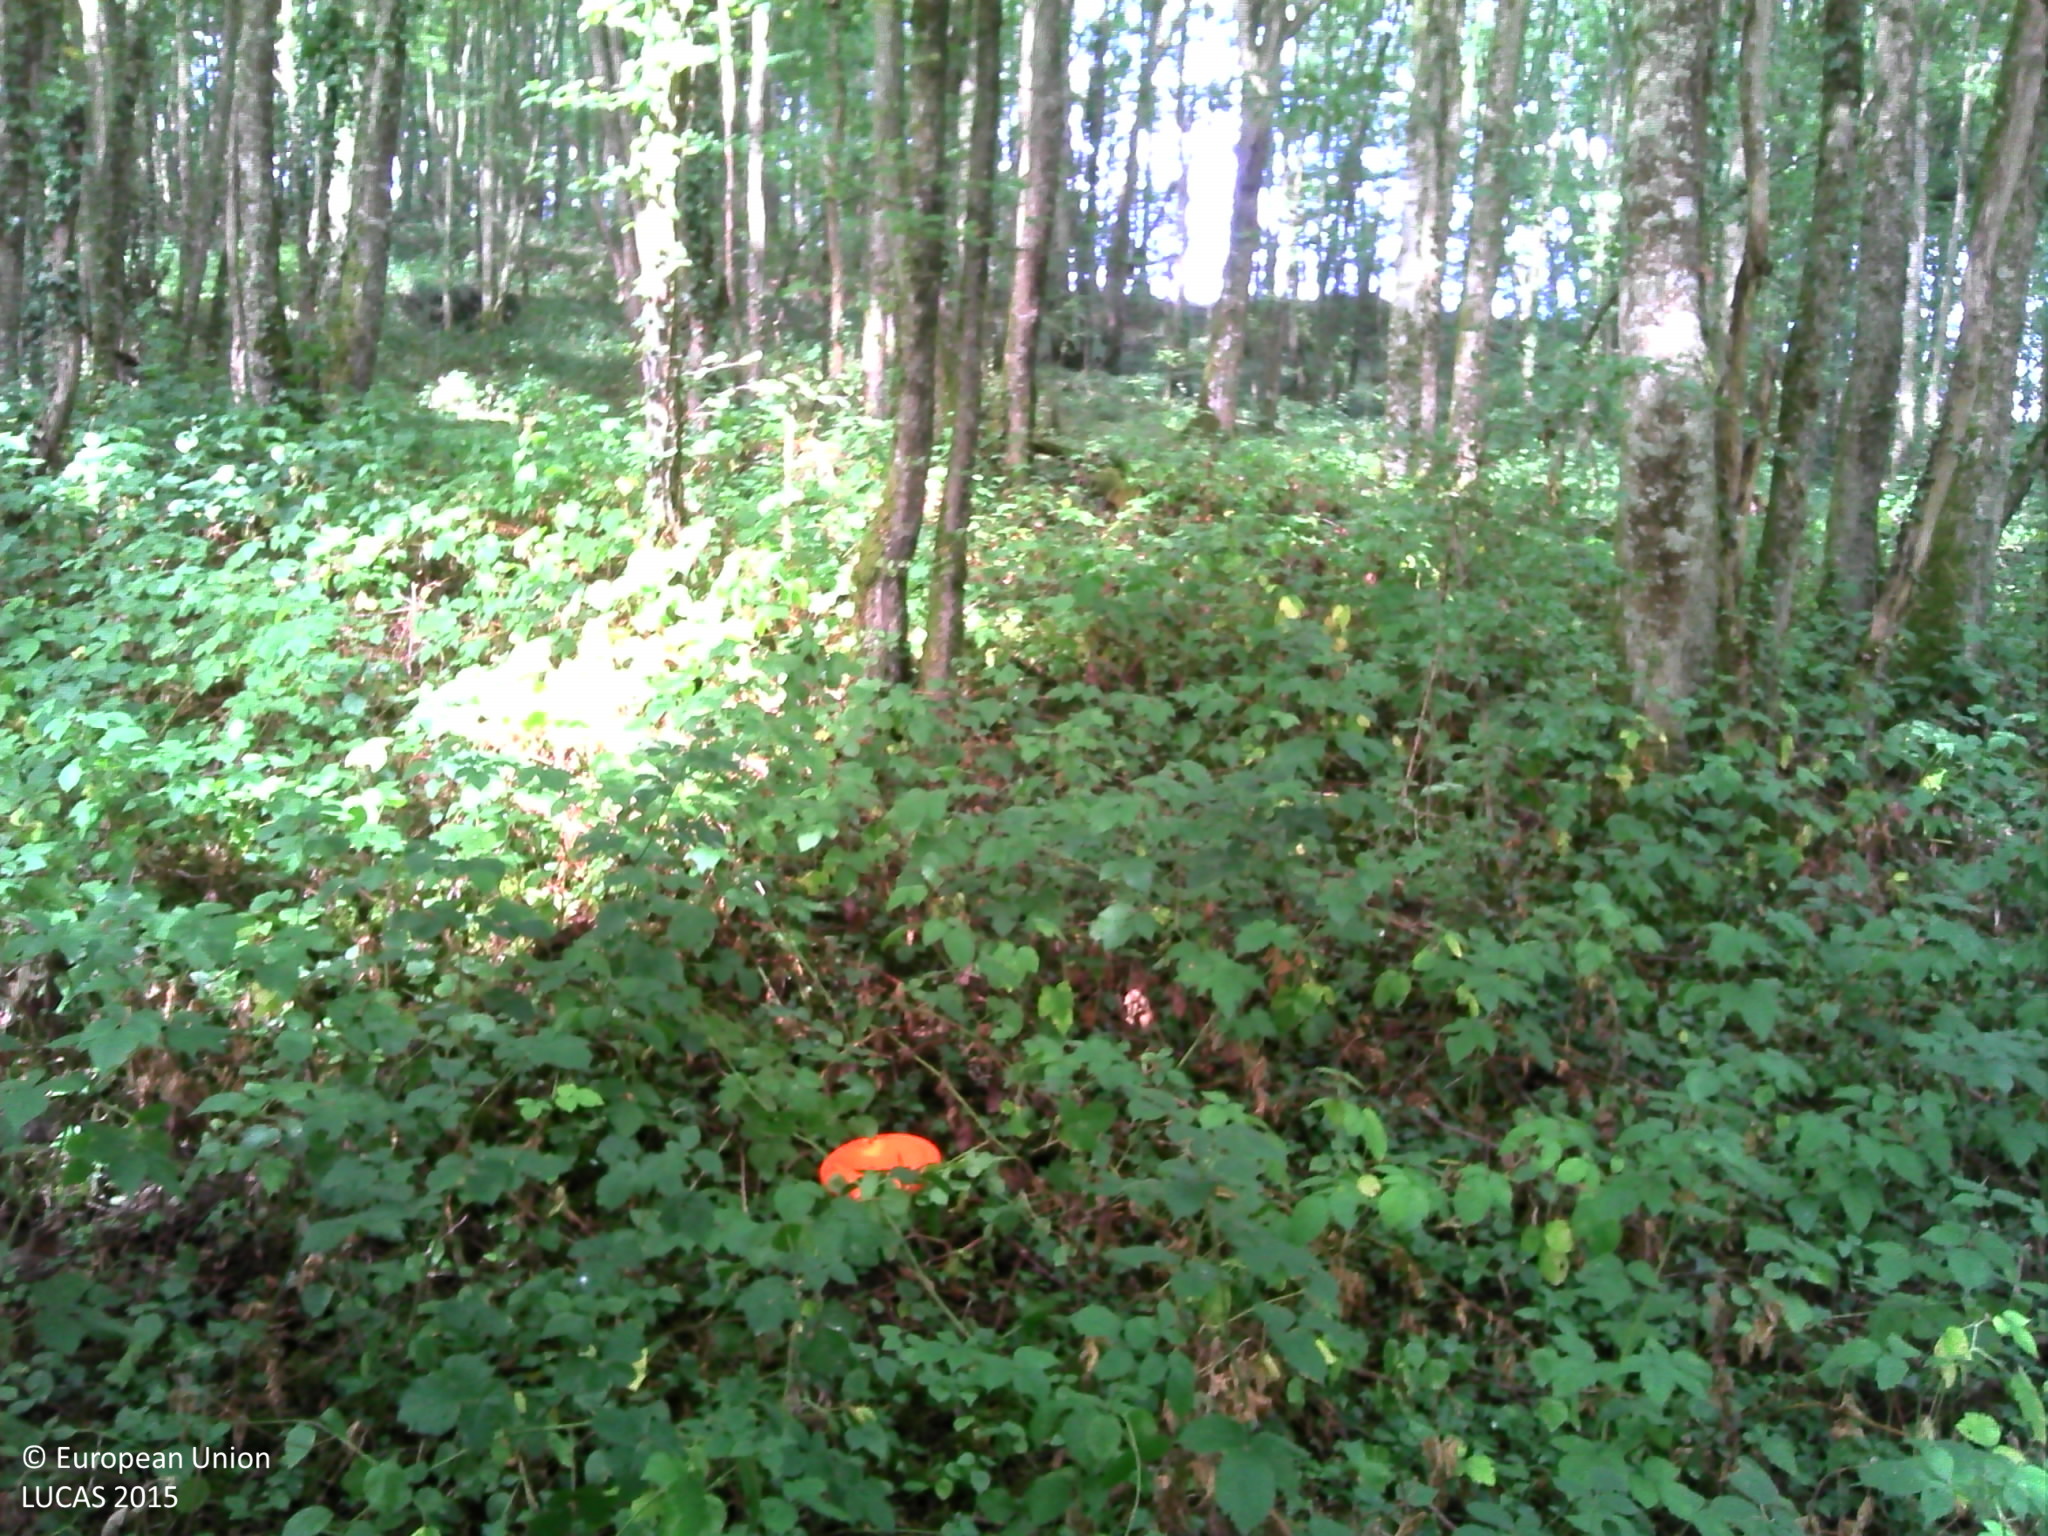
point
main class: Woodland
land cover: Broadleaved woodland
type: mesophytic deciduous forest
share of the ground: > 75 %
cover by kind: broadleaved forest trees 90 %, herbaceous plants 5 %, lichens and mosses 5 %
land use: Forestry
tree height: > 5 m
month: July
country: FR
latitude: 47.9154
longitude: 3.0756
